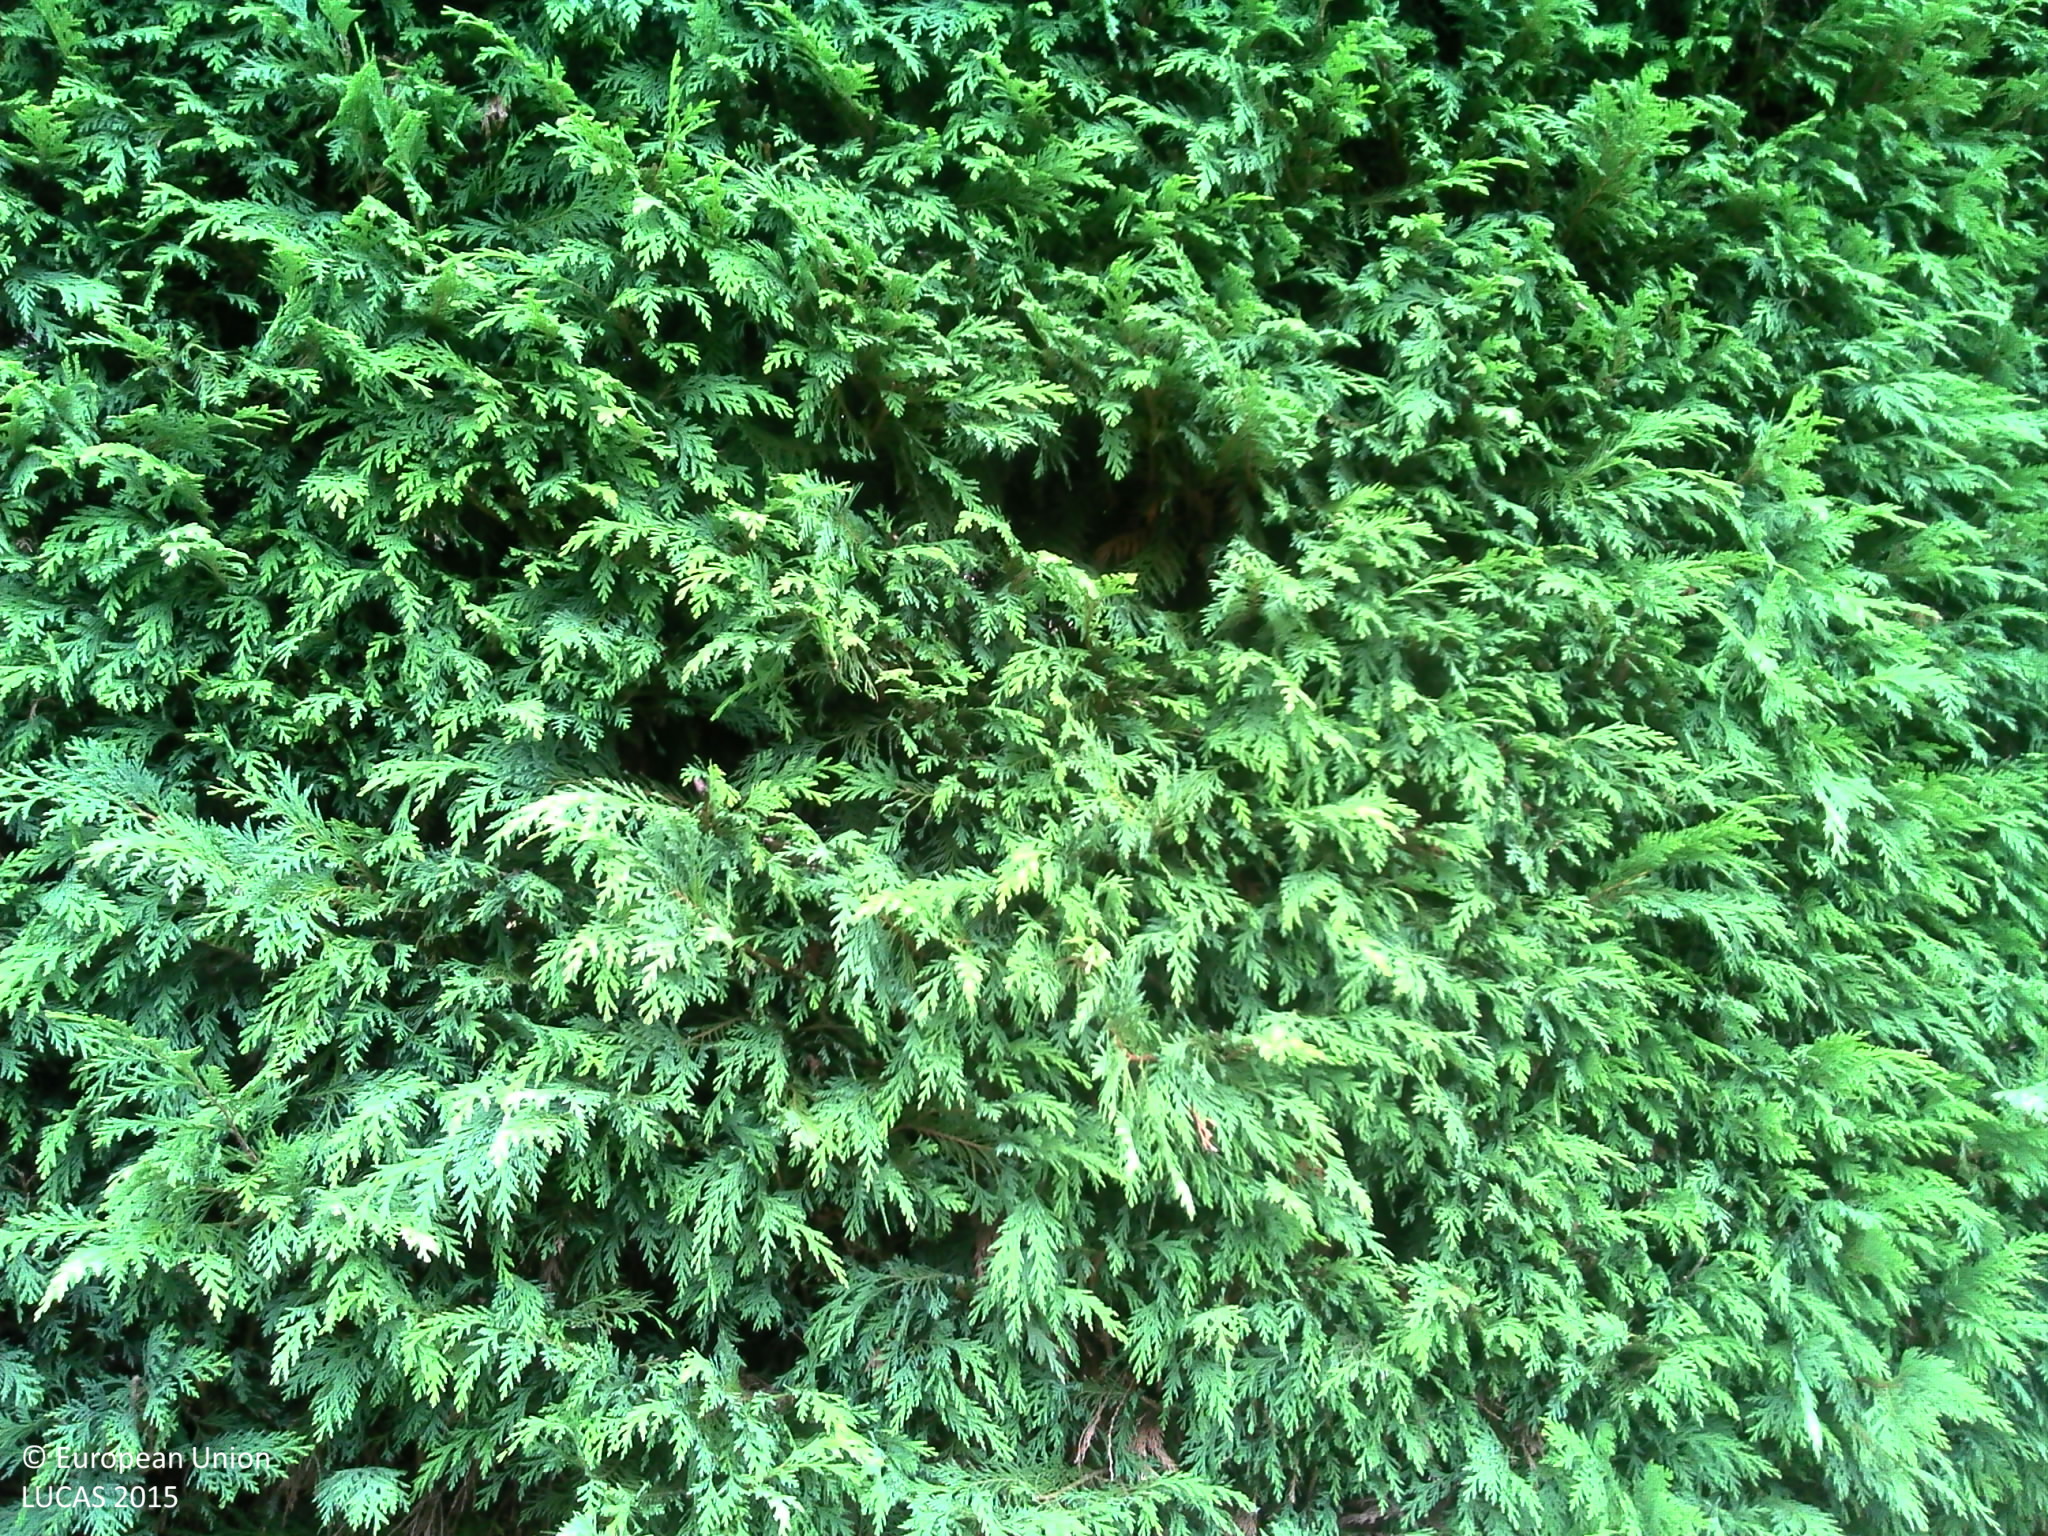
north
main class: Grassland
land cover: Grassland without tree/shrub cover
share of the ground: > 75 %
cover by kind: herbaceous plants 90 %, unconsolidated bare surface 5 %
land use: Residential
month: July
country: FR
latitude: 45.5314
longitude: 1.3752
